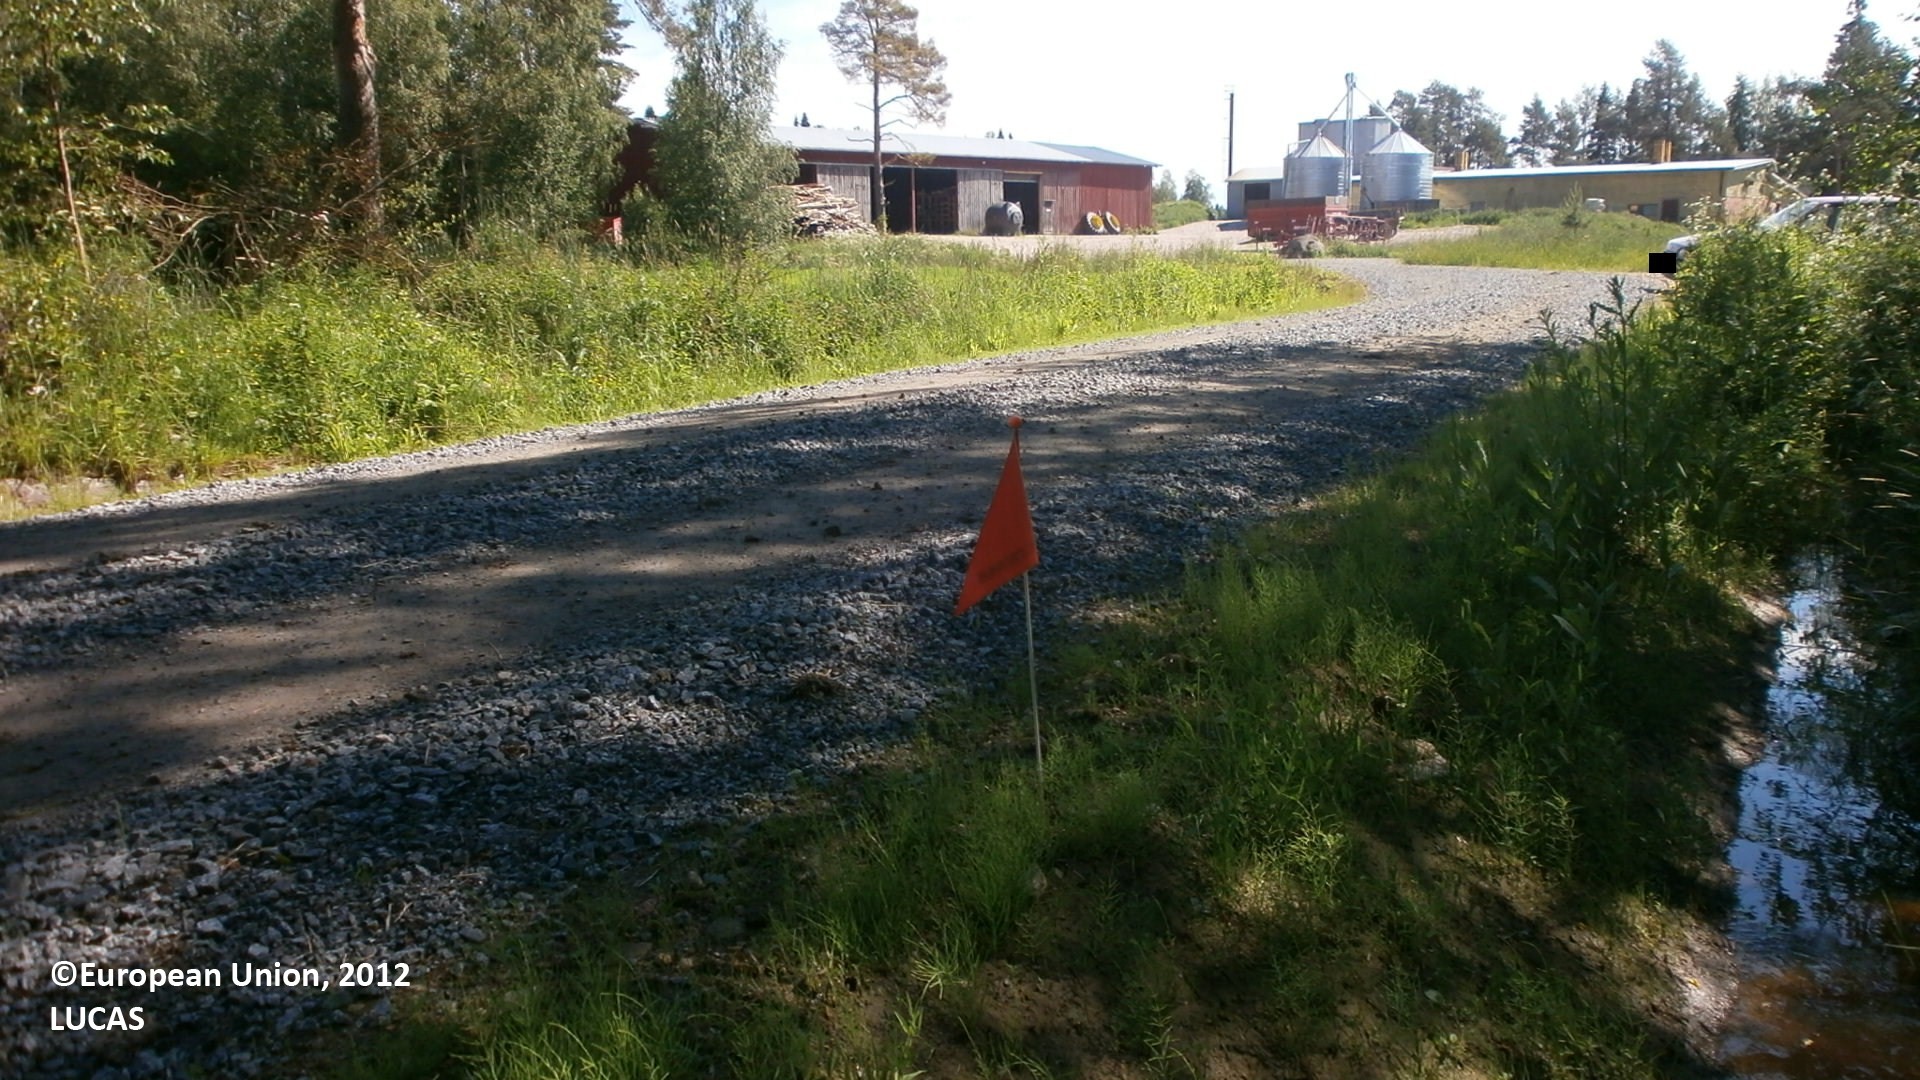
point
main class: Woodland
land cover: Spruce dominated mixed woodland
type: boreal forest
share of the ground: 50 - 75 %
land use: Forestry
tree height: > 5 m
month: July
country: FI
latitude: 63.9670
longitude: 24.8886
